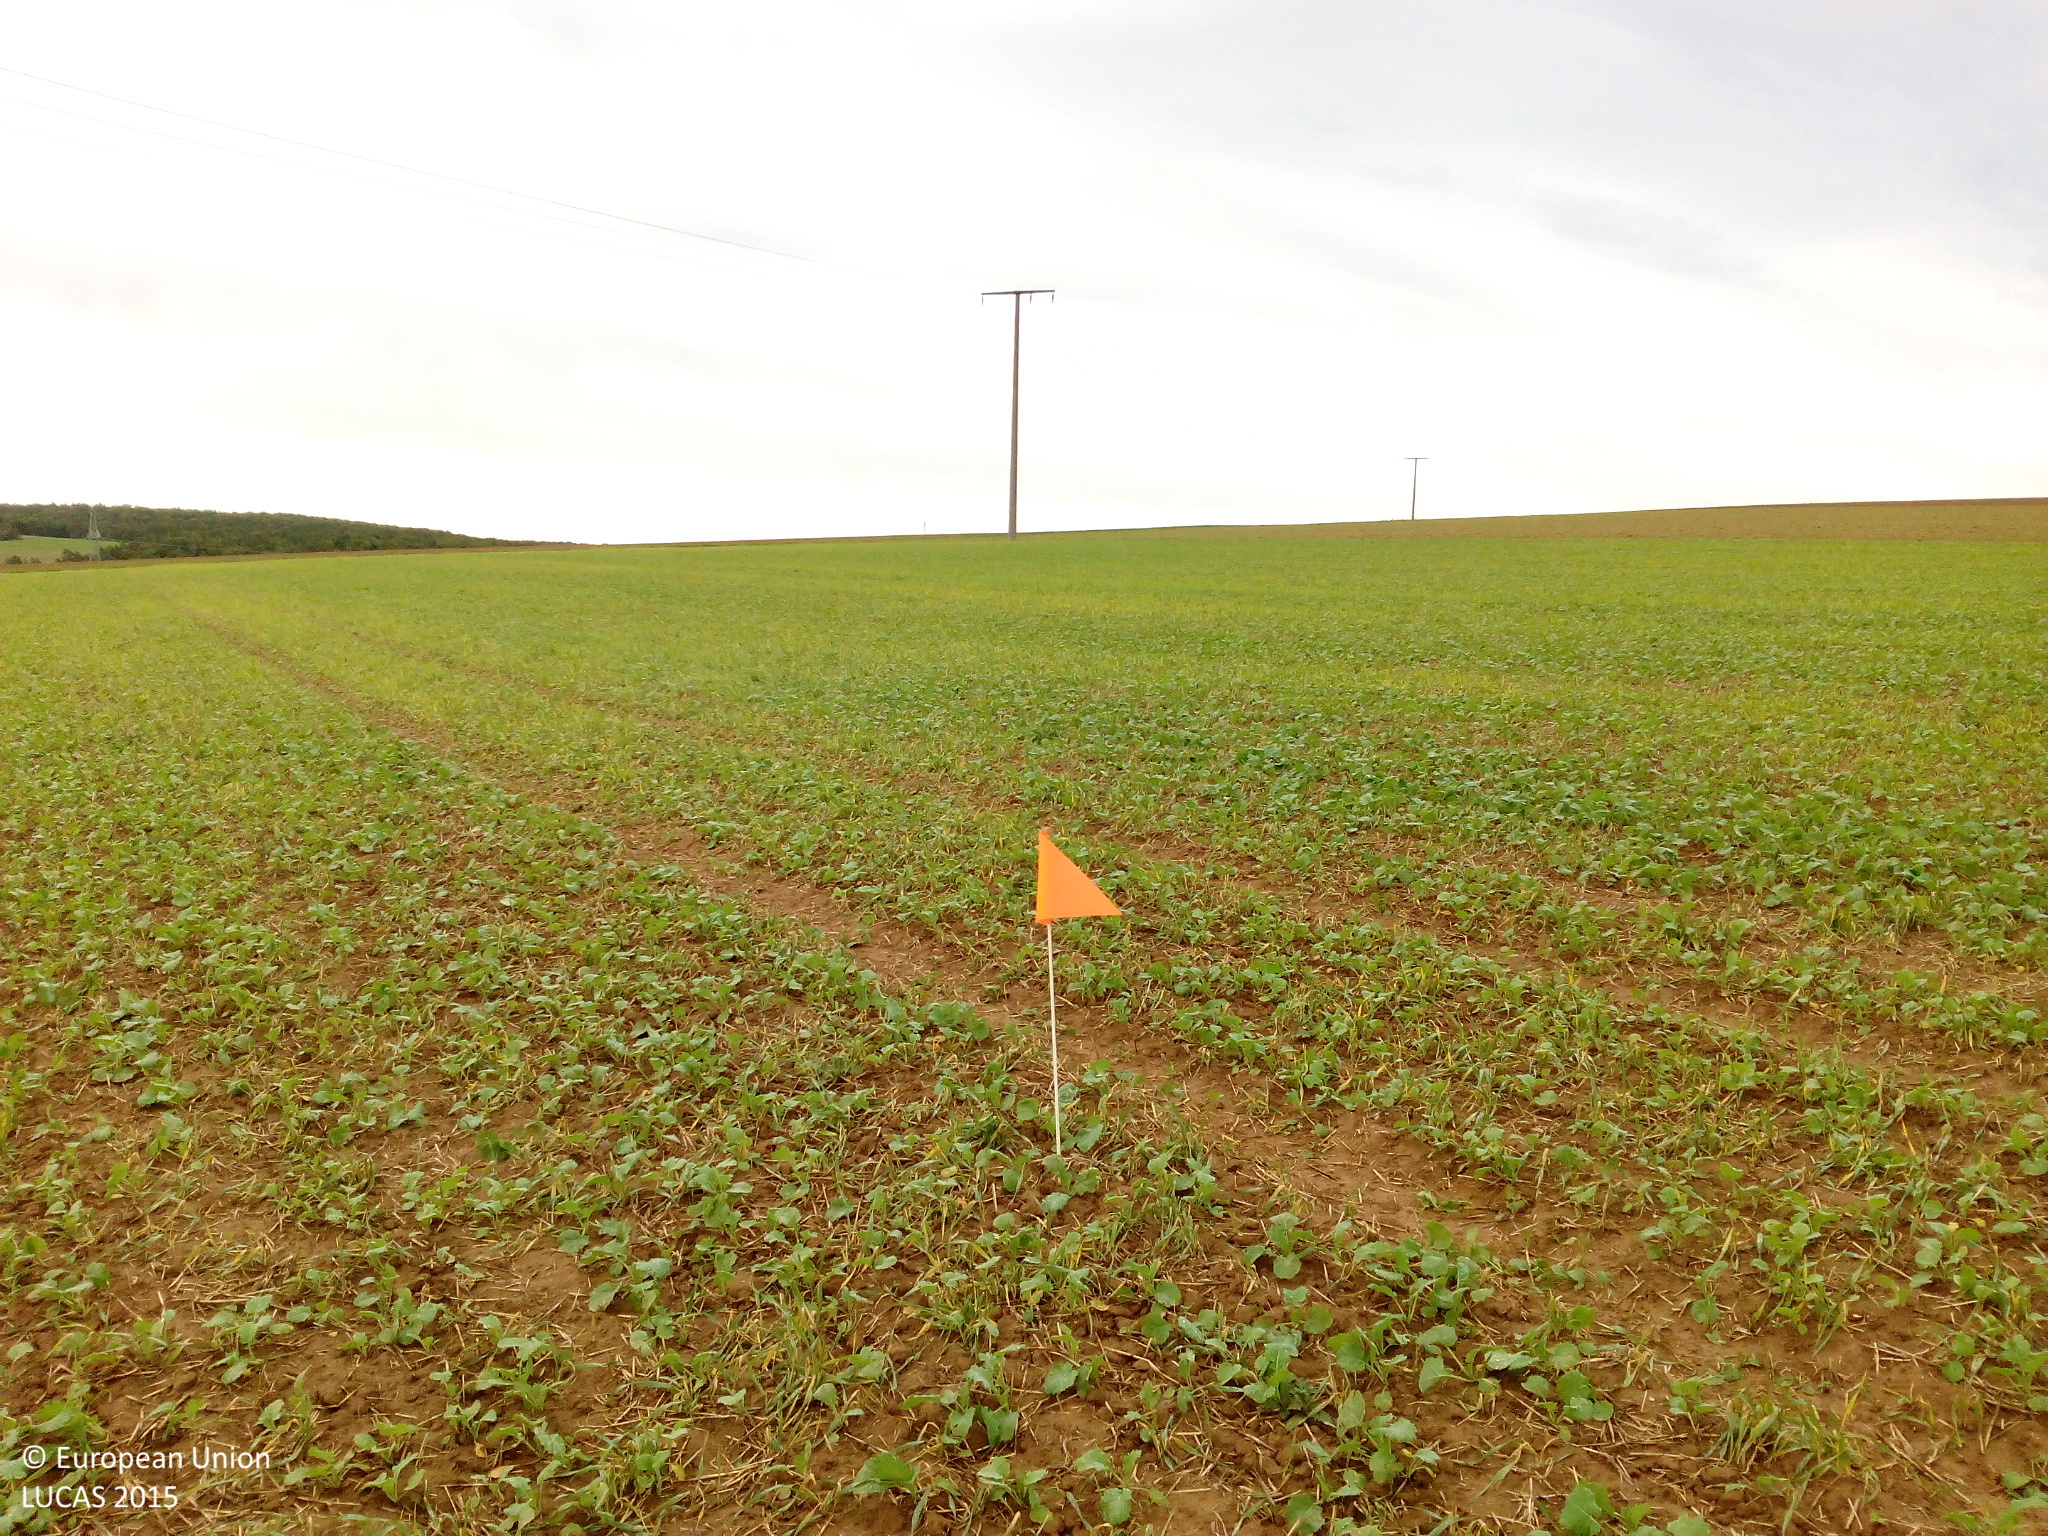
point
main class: Cropland
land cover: Barley
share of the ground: < 10 %
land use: Agriculture (excluding fallow land and kitchen gardens)
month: September
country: DE
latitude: 50.0403
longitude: 9.9023
